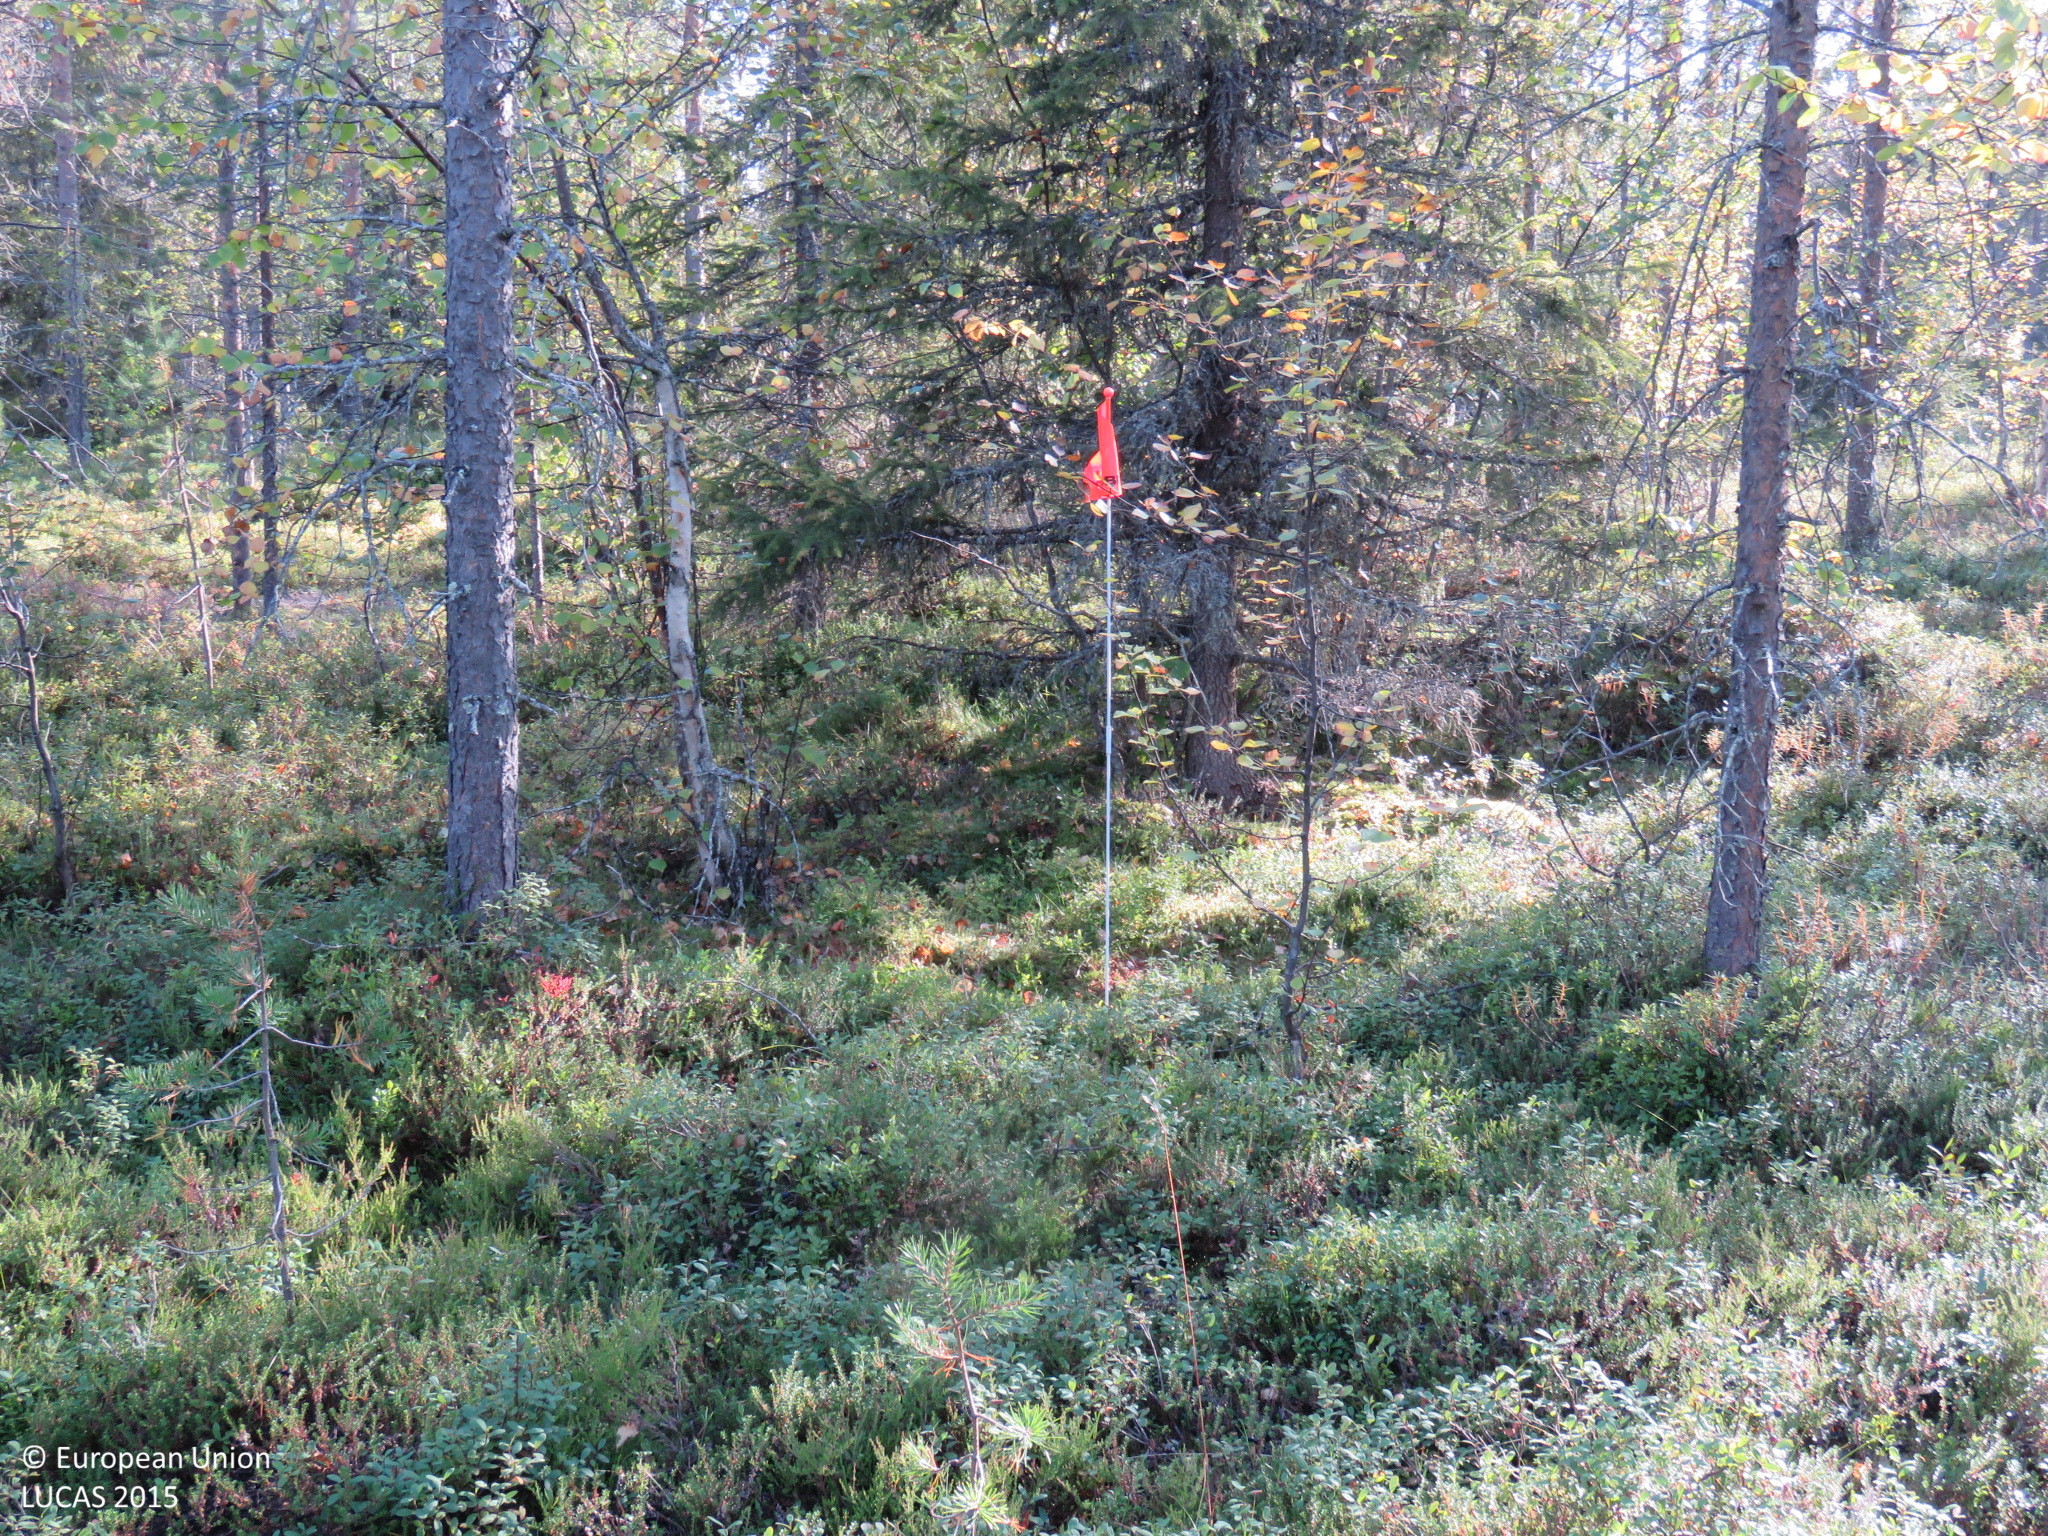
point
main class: Woodland
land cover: Other mixed woodland
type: boreal forest
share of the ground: > 75 %
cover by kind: coniferous forest trees 50 %, broadleaved forest trees 25 %, shrubs 20 %, lichens and mosses 5 %
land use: Forestry
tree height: > 5 m
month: September
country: FI
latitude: 65.5267
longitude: 27.5897
